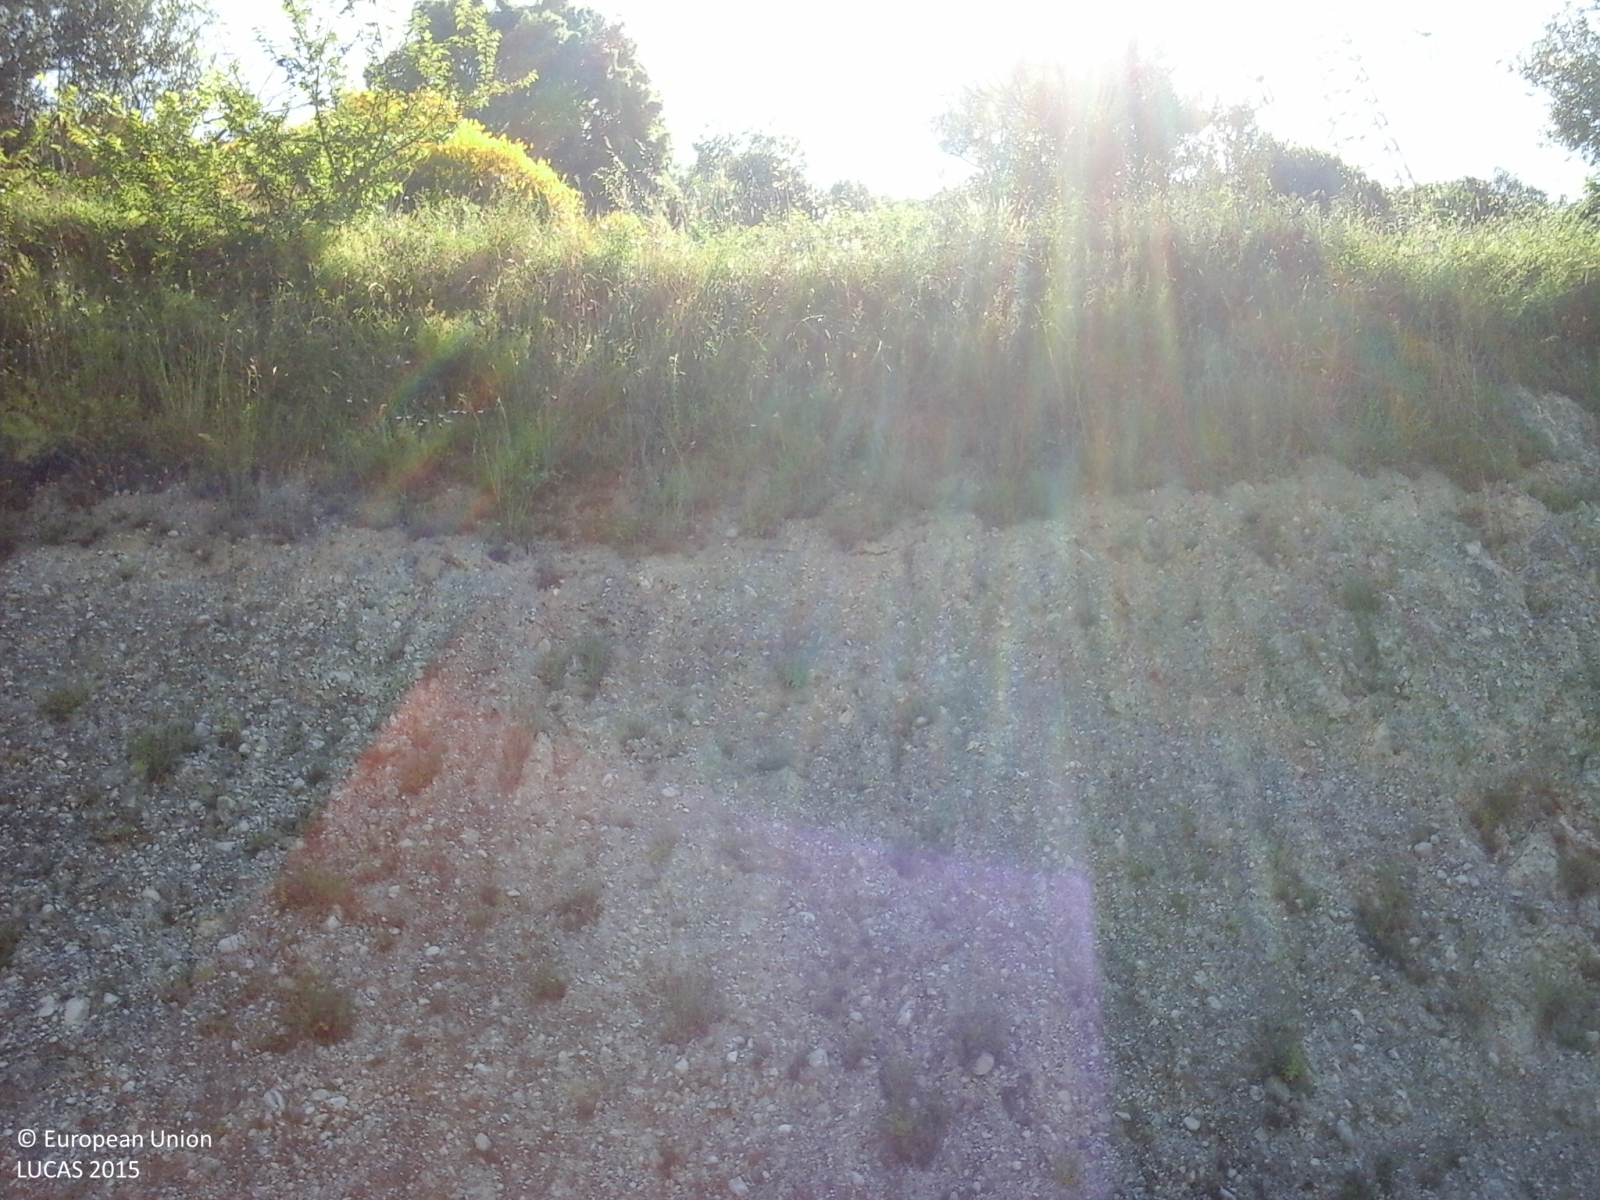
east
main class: Cropland
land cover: Olive groves
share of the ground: 50 - 75 %
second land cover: Grassland without tree/shrub cover
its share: 50 - 75 %
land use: Abandoned areas
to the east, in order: Olive groves; Grassland without tree/shrub cover; Shrubland without tree cover; Paved roads, cycling and walking lanes; Grass margins; Rock outcrops; Shrubland with sparse tree cover; Olive groves; Shrubland without tree cover; Electric lines; Shrubland without tree cover; Olive groves
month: June
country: IT
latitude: 40.6267
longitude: 15.0508
